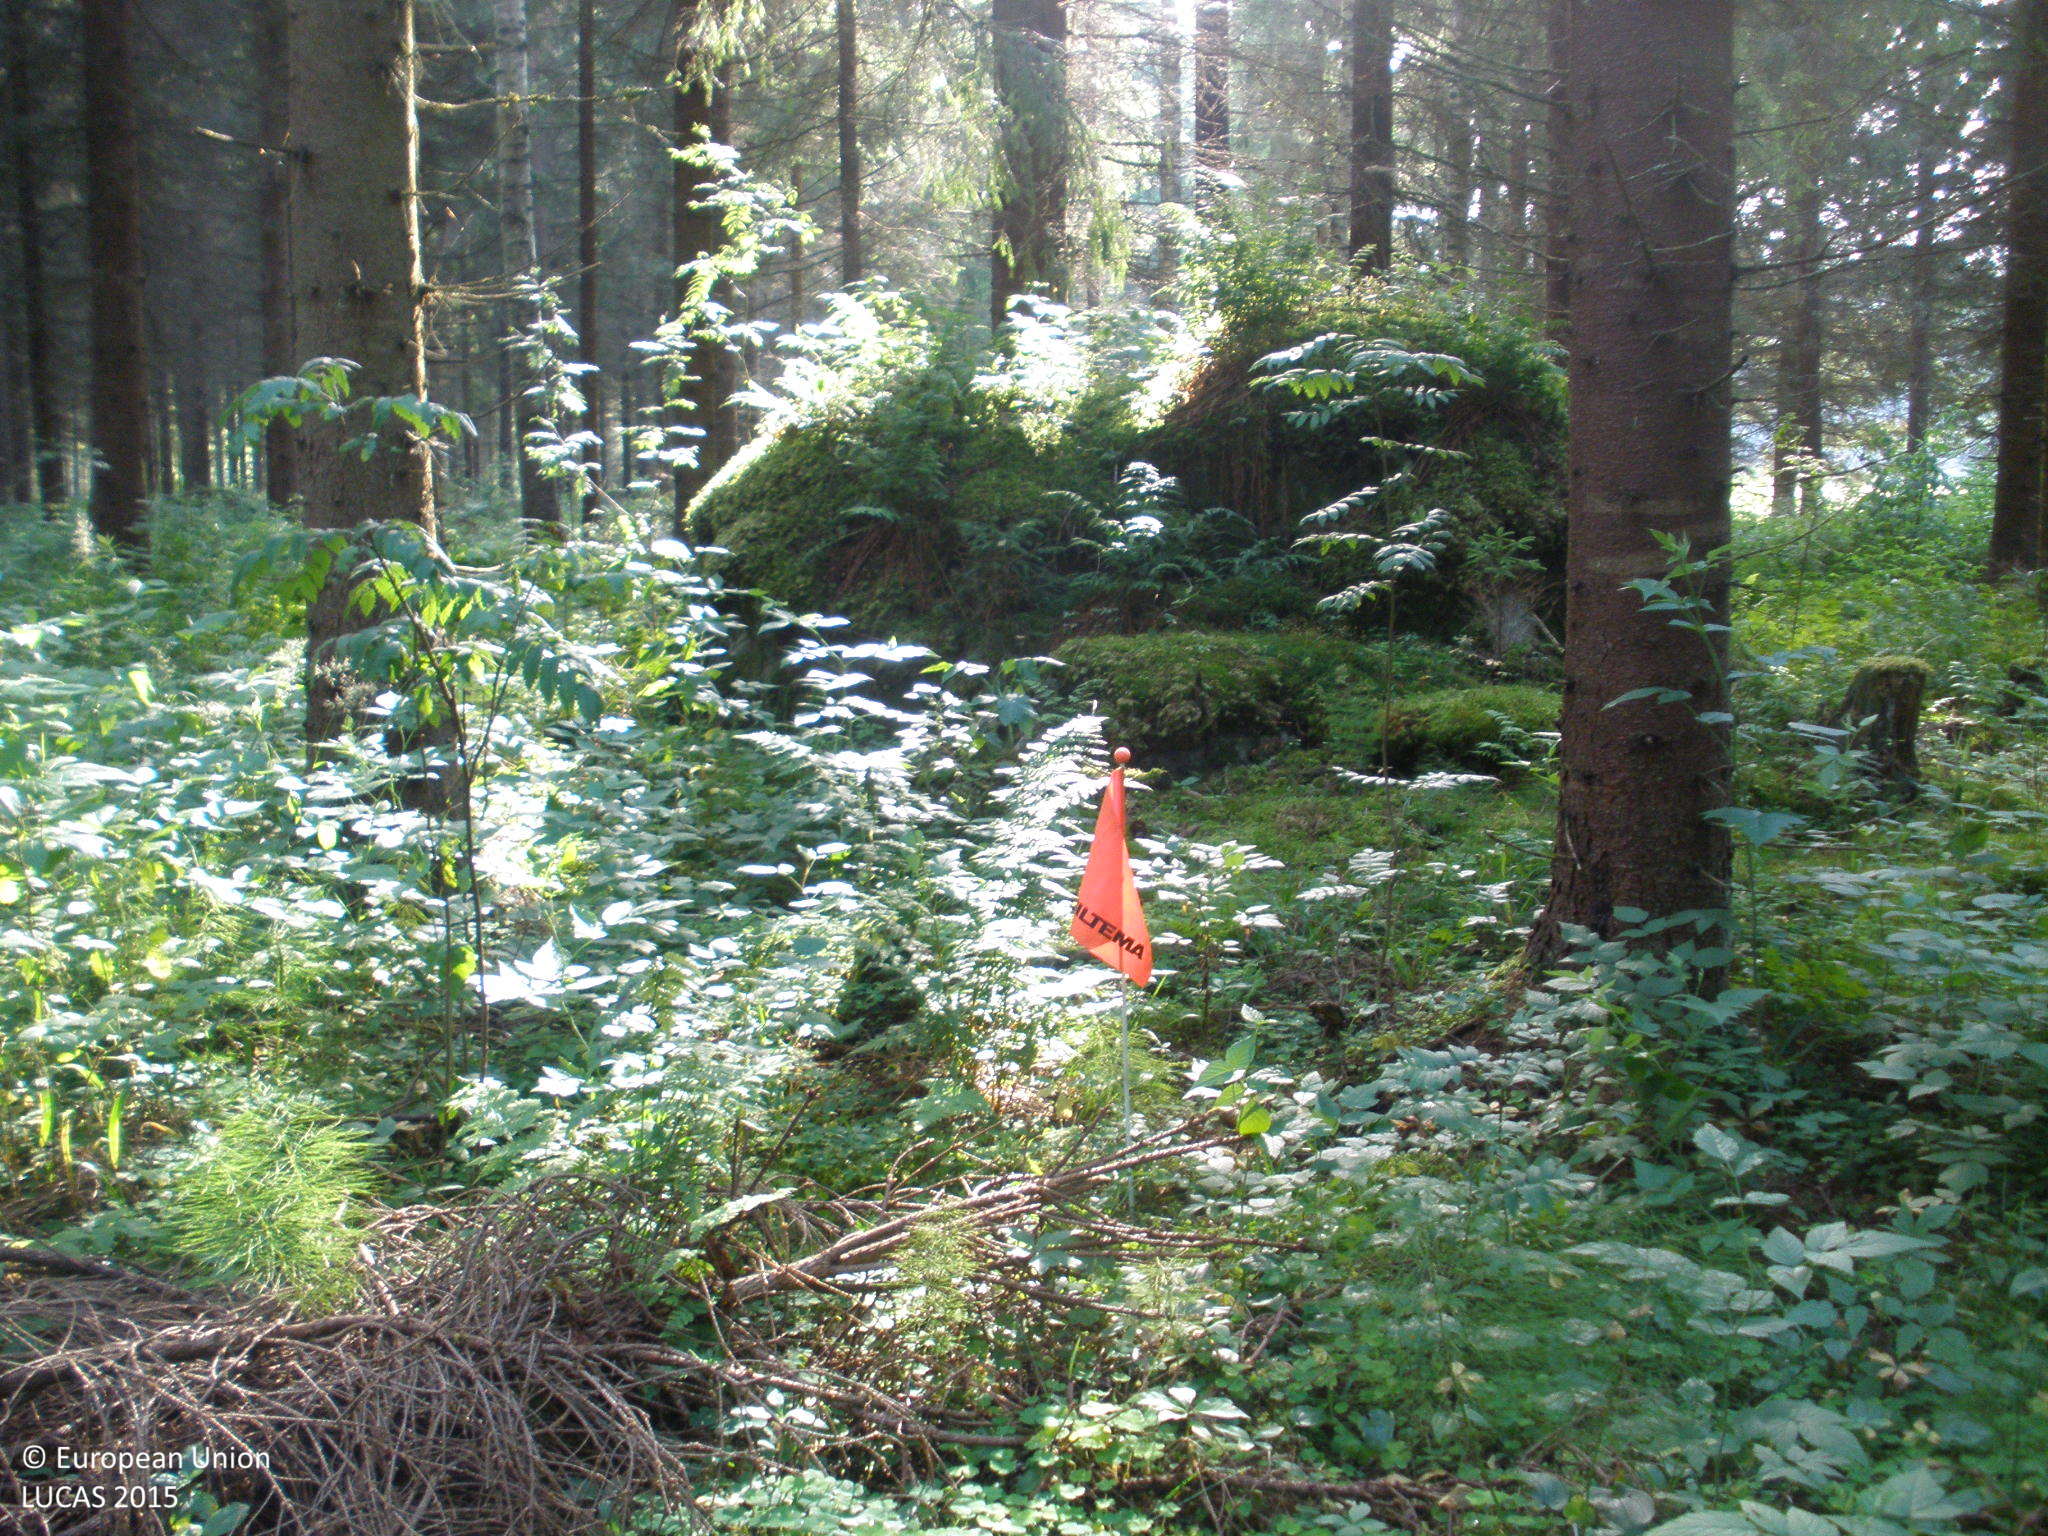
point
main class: Woodland
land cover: Spruce dominated coniferous woodland
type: boreal forest
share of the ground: > 75 %
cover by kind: coniferous forest trees 85 %, lichens and mosses 10 %, herbaceous plants 5 %
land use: Forestry
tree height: > 5 m
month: July
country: FI
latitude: 61.1380
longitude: 24.9879
